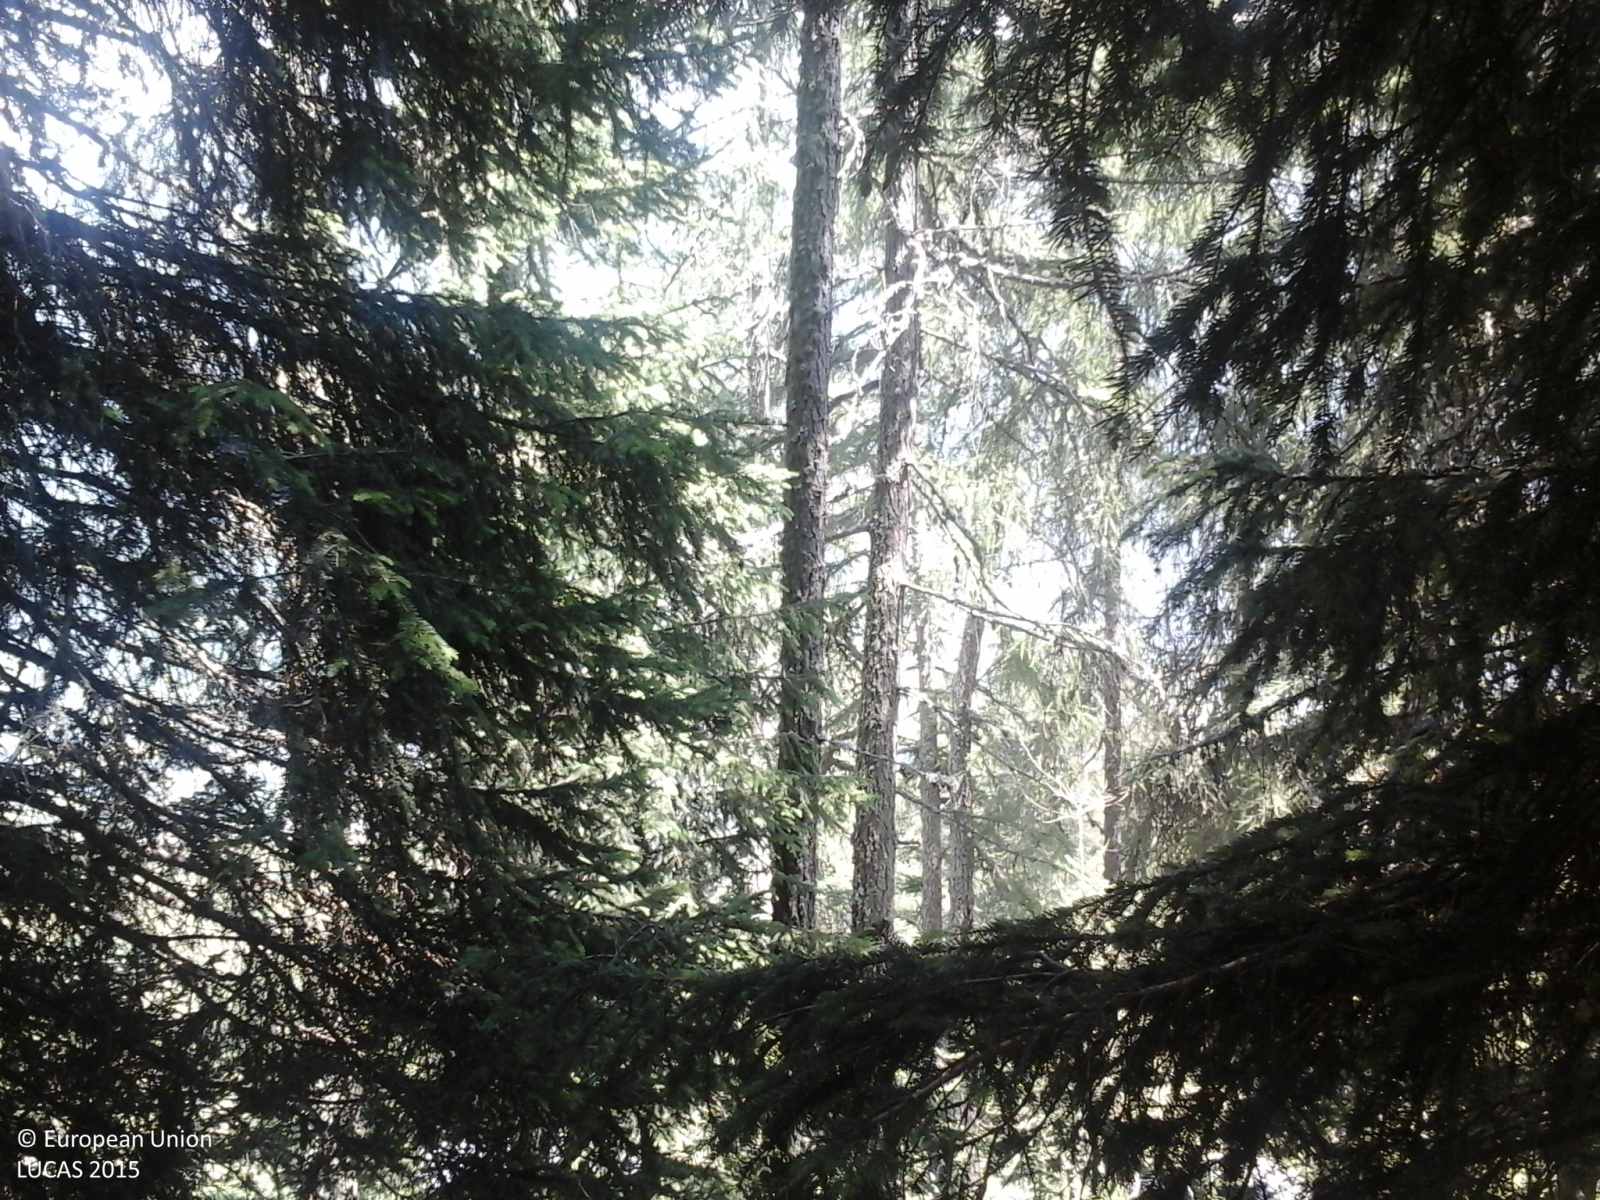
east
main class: Woodland
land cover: Other coniferous woodland
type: alpine coniferous forest
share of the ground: > 75 %
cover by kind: coniferous forest trees 100 %
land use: Forestry
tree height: > 5 m
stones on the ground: < 10 %
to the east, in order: Other coniferous woodland; Tracks; Grass margins; Dry stone walls; Other coniferous woodland; Grassland without tree/shrub cover; Ditches and canals; Grassland without tree/shrub cover; Tracks; Grassland without tree/shrub cover; Electric lines; Grassland without tree/shrub cover; Tracks; Grassland without tree/shrub cover; Other coniferous woodland; Tracks; Other coniferous woodland; Grassland without tree/shrub cover; Dry stone walls; Grassland without tree/shrub cover; Managed hedges; Dry stone walls; Grassland without tree/shrub cover; Managed hedges; Grassland without tree/shrub cover
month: July
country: IT
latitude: 45.8033
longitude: 7.6743
